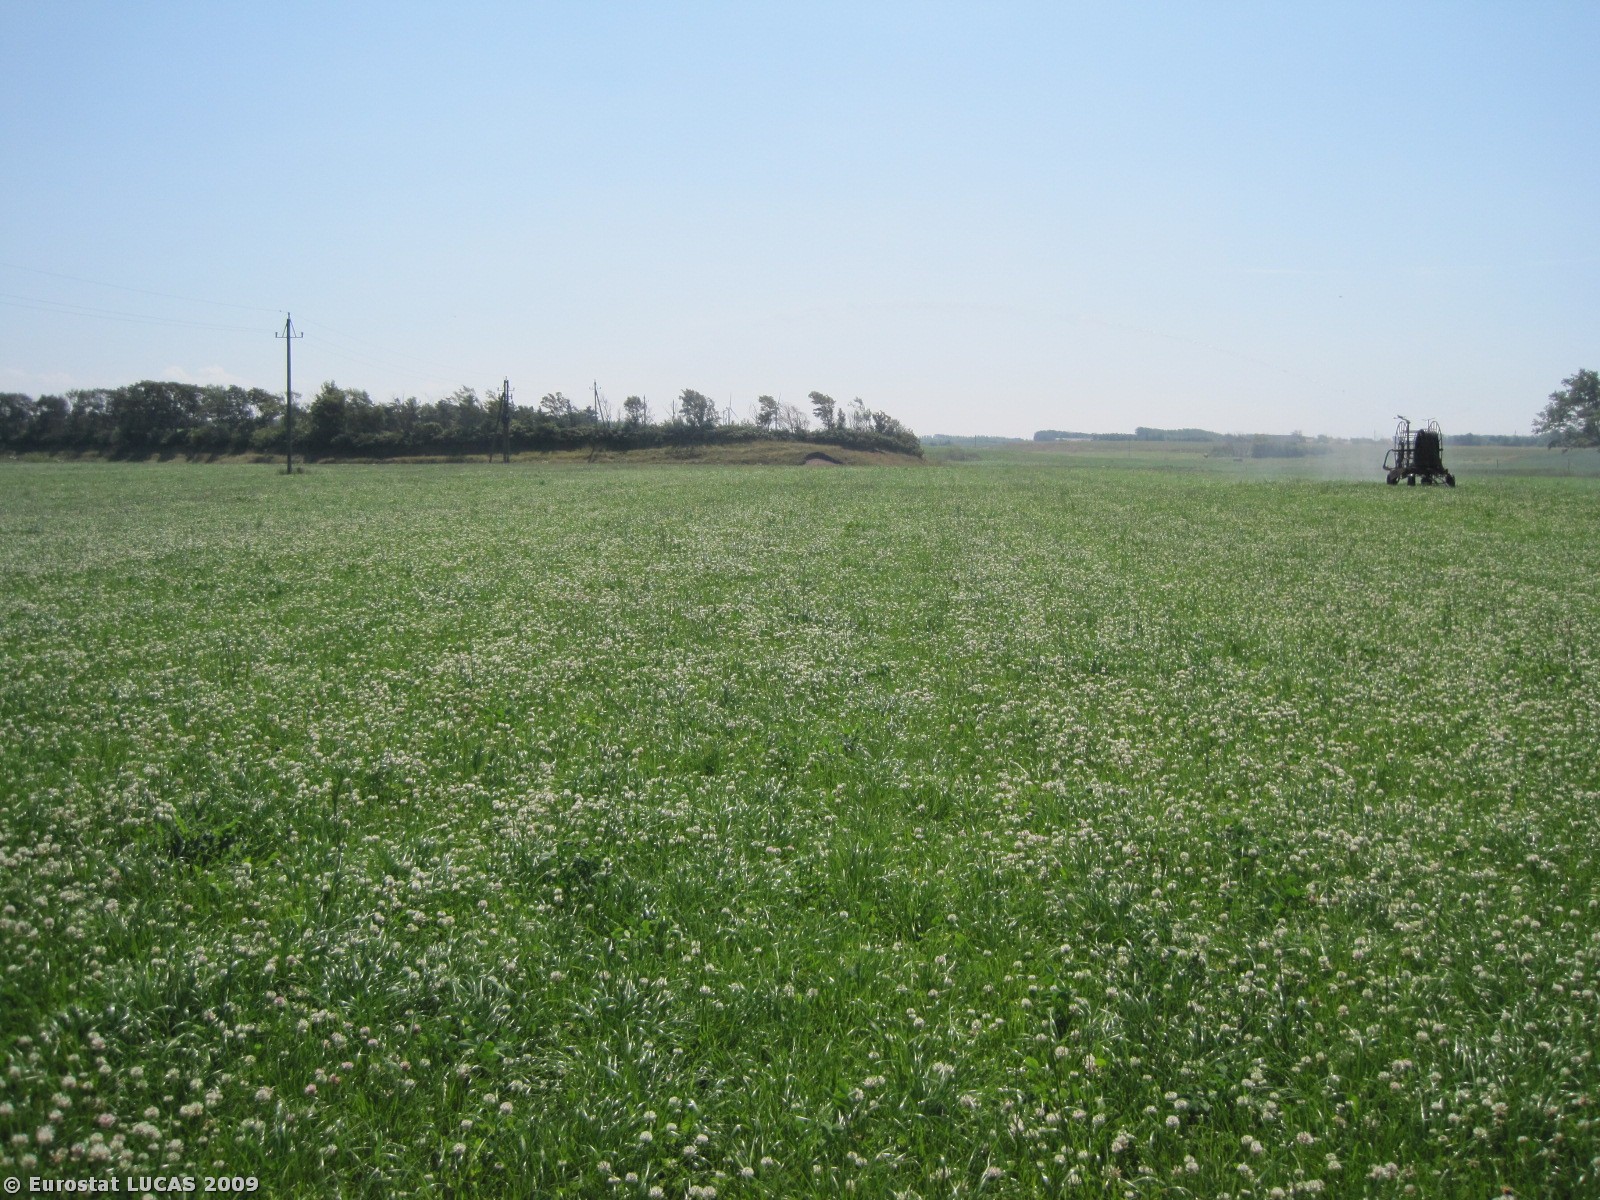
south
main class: Grassland
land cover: Grassland without tree/shrub cover
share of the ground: > 75 %
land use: Agriculture (excluding fallow land and kitchen gardens)
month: July
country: DK
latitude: 56.4637
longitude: 8.2655
